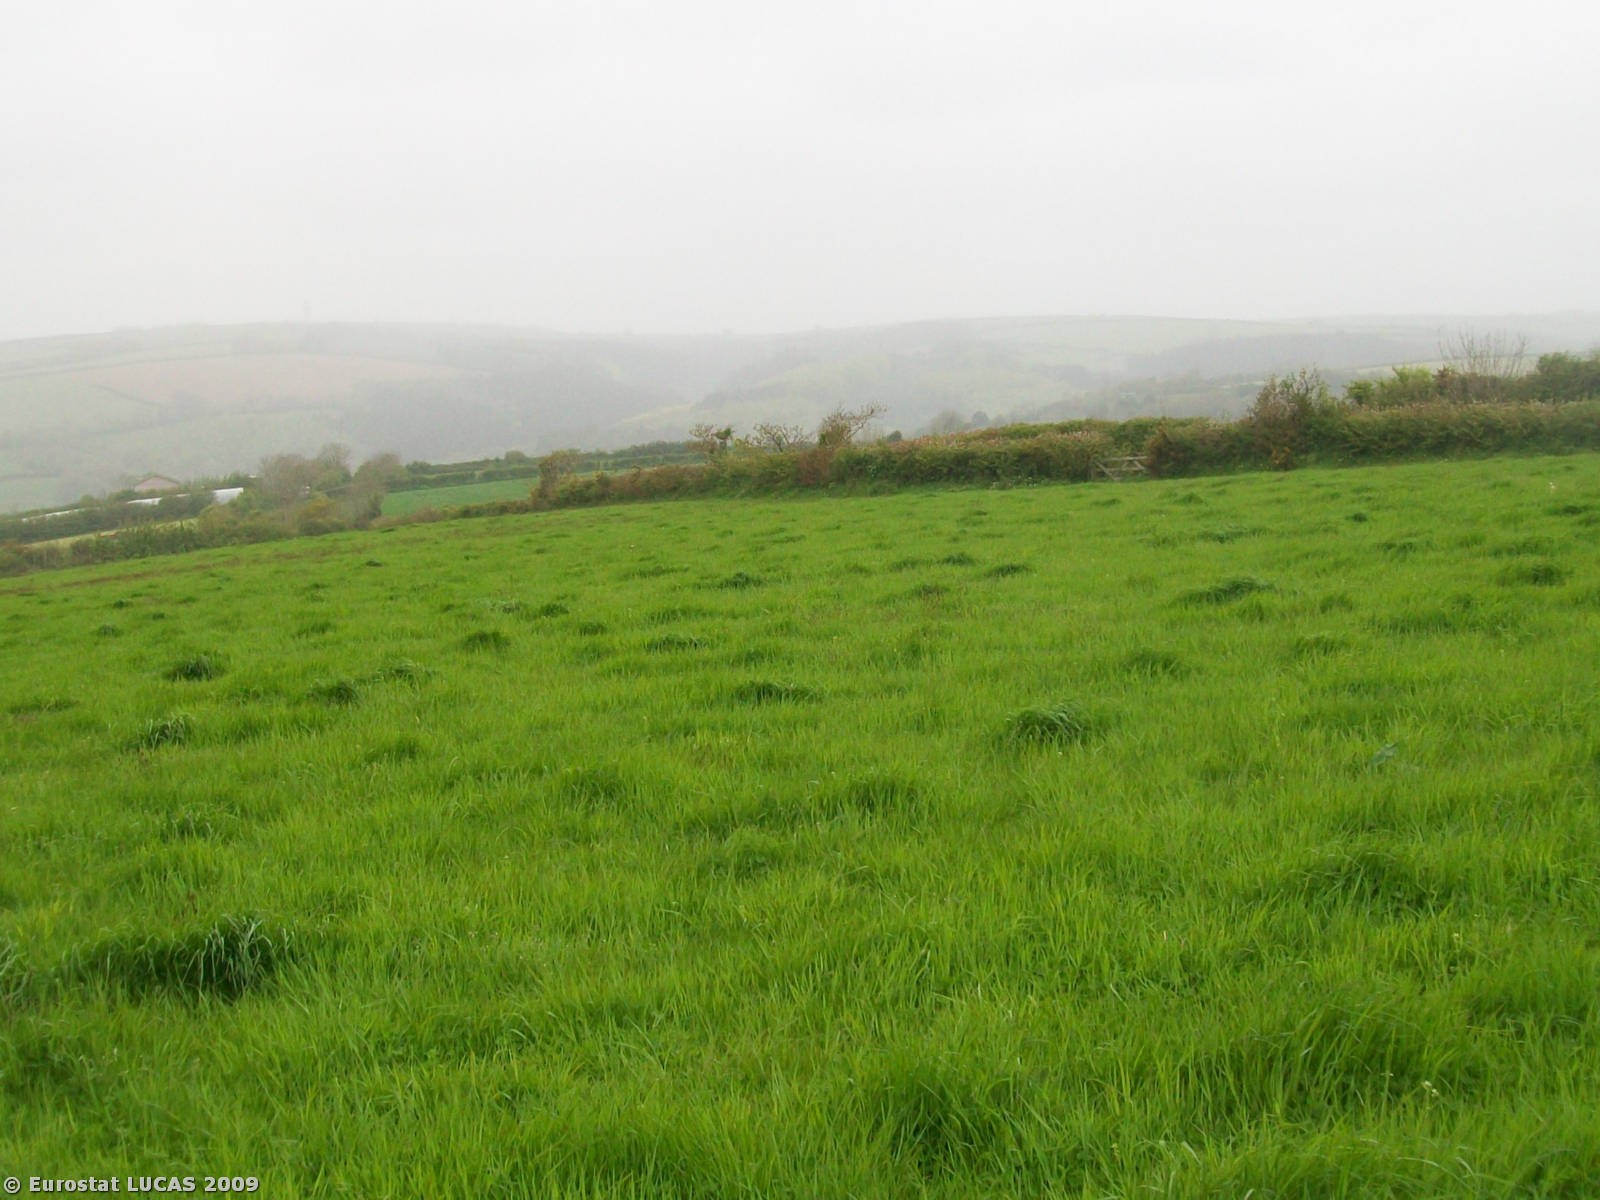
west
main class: Grassland
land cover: Grassland without tree/shrub cover
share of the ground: > 75 %
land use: Agriculture (excluding fallow land and kitchen gardens)
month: May
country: GB
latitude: 50.4202
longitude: -4.5026
